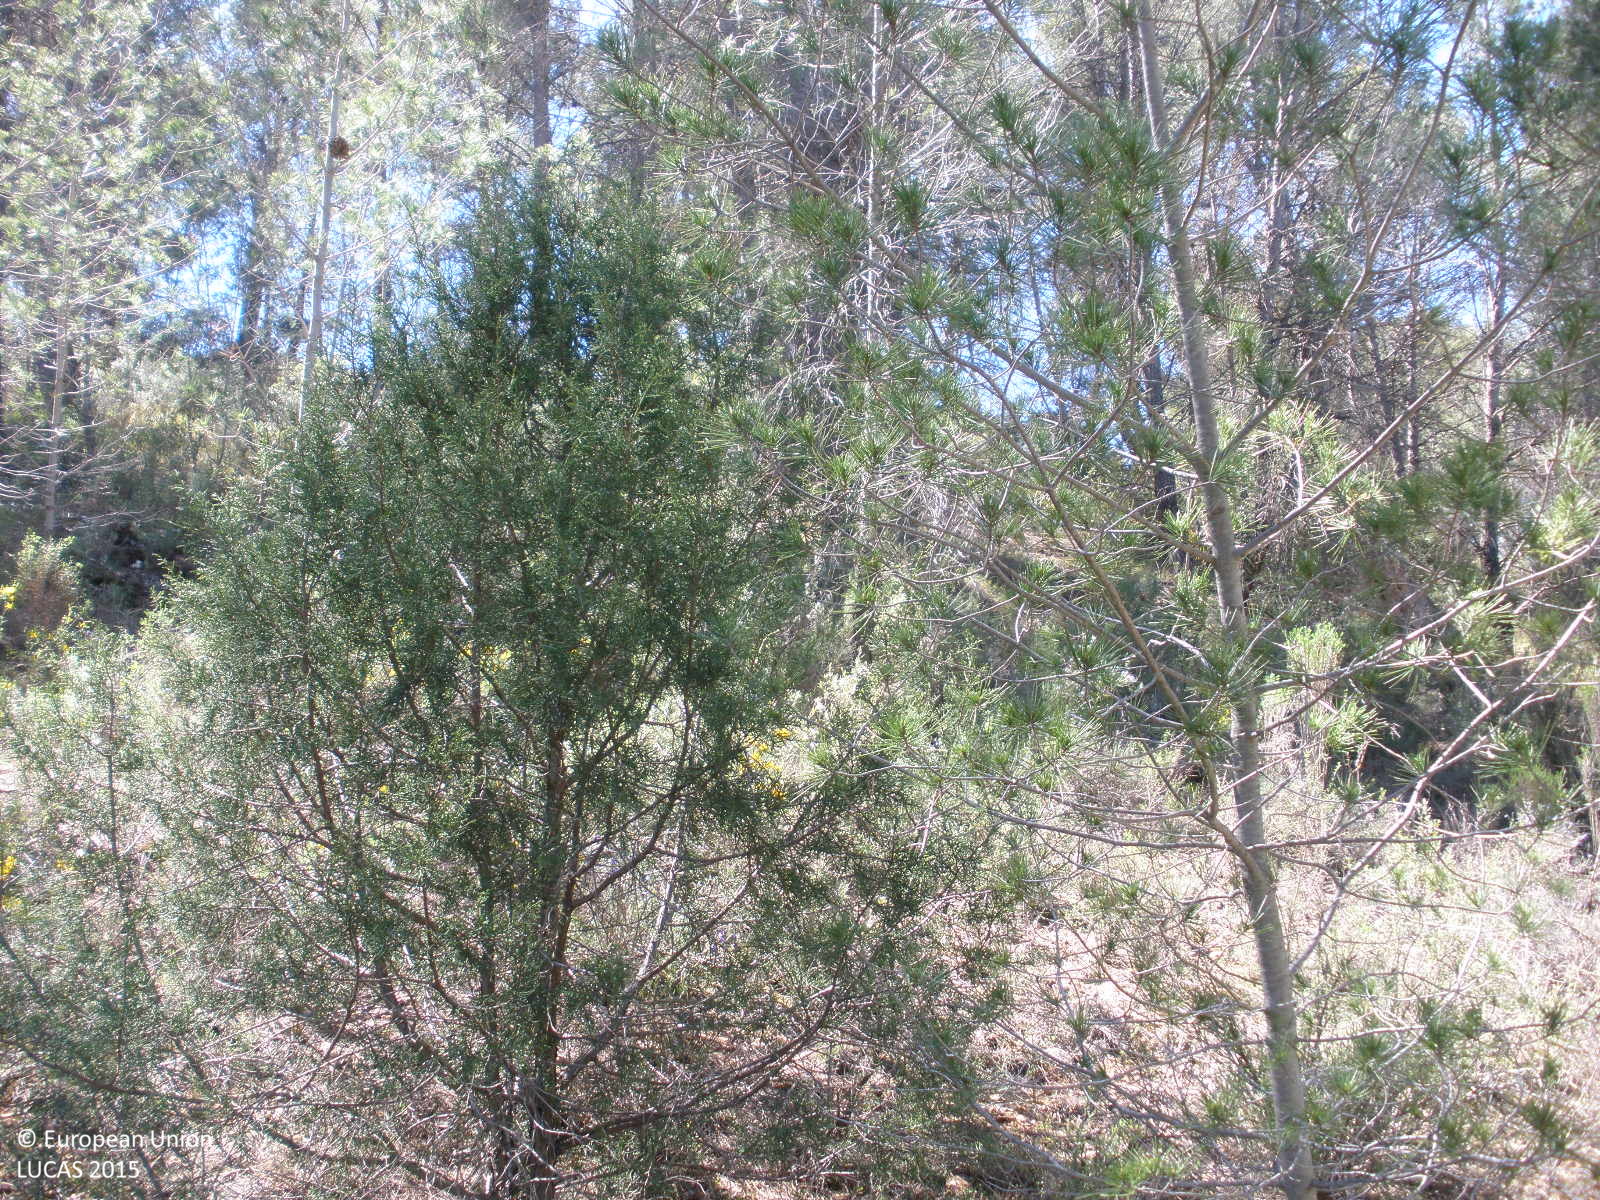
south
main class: Woodland
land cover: Pine dominated coniferous woodland
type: coniferous forest of the mediterranean region
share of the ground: 25 - 50 %
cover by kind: shrubs 60 %, coniferous forest trees 40 %
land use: Semi-natural and natural areas not in use
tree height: > 5 m
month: April
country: ES
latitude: 40.1302
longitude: -1.2402
